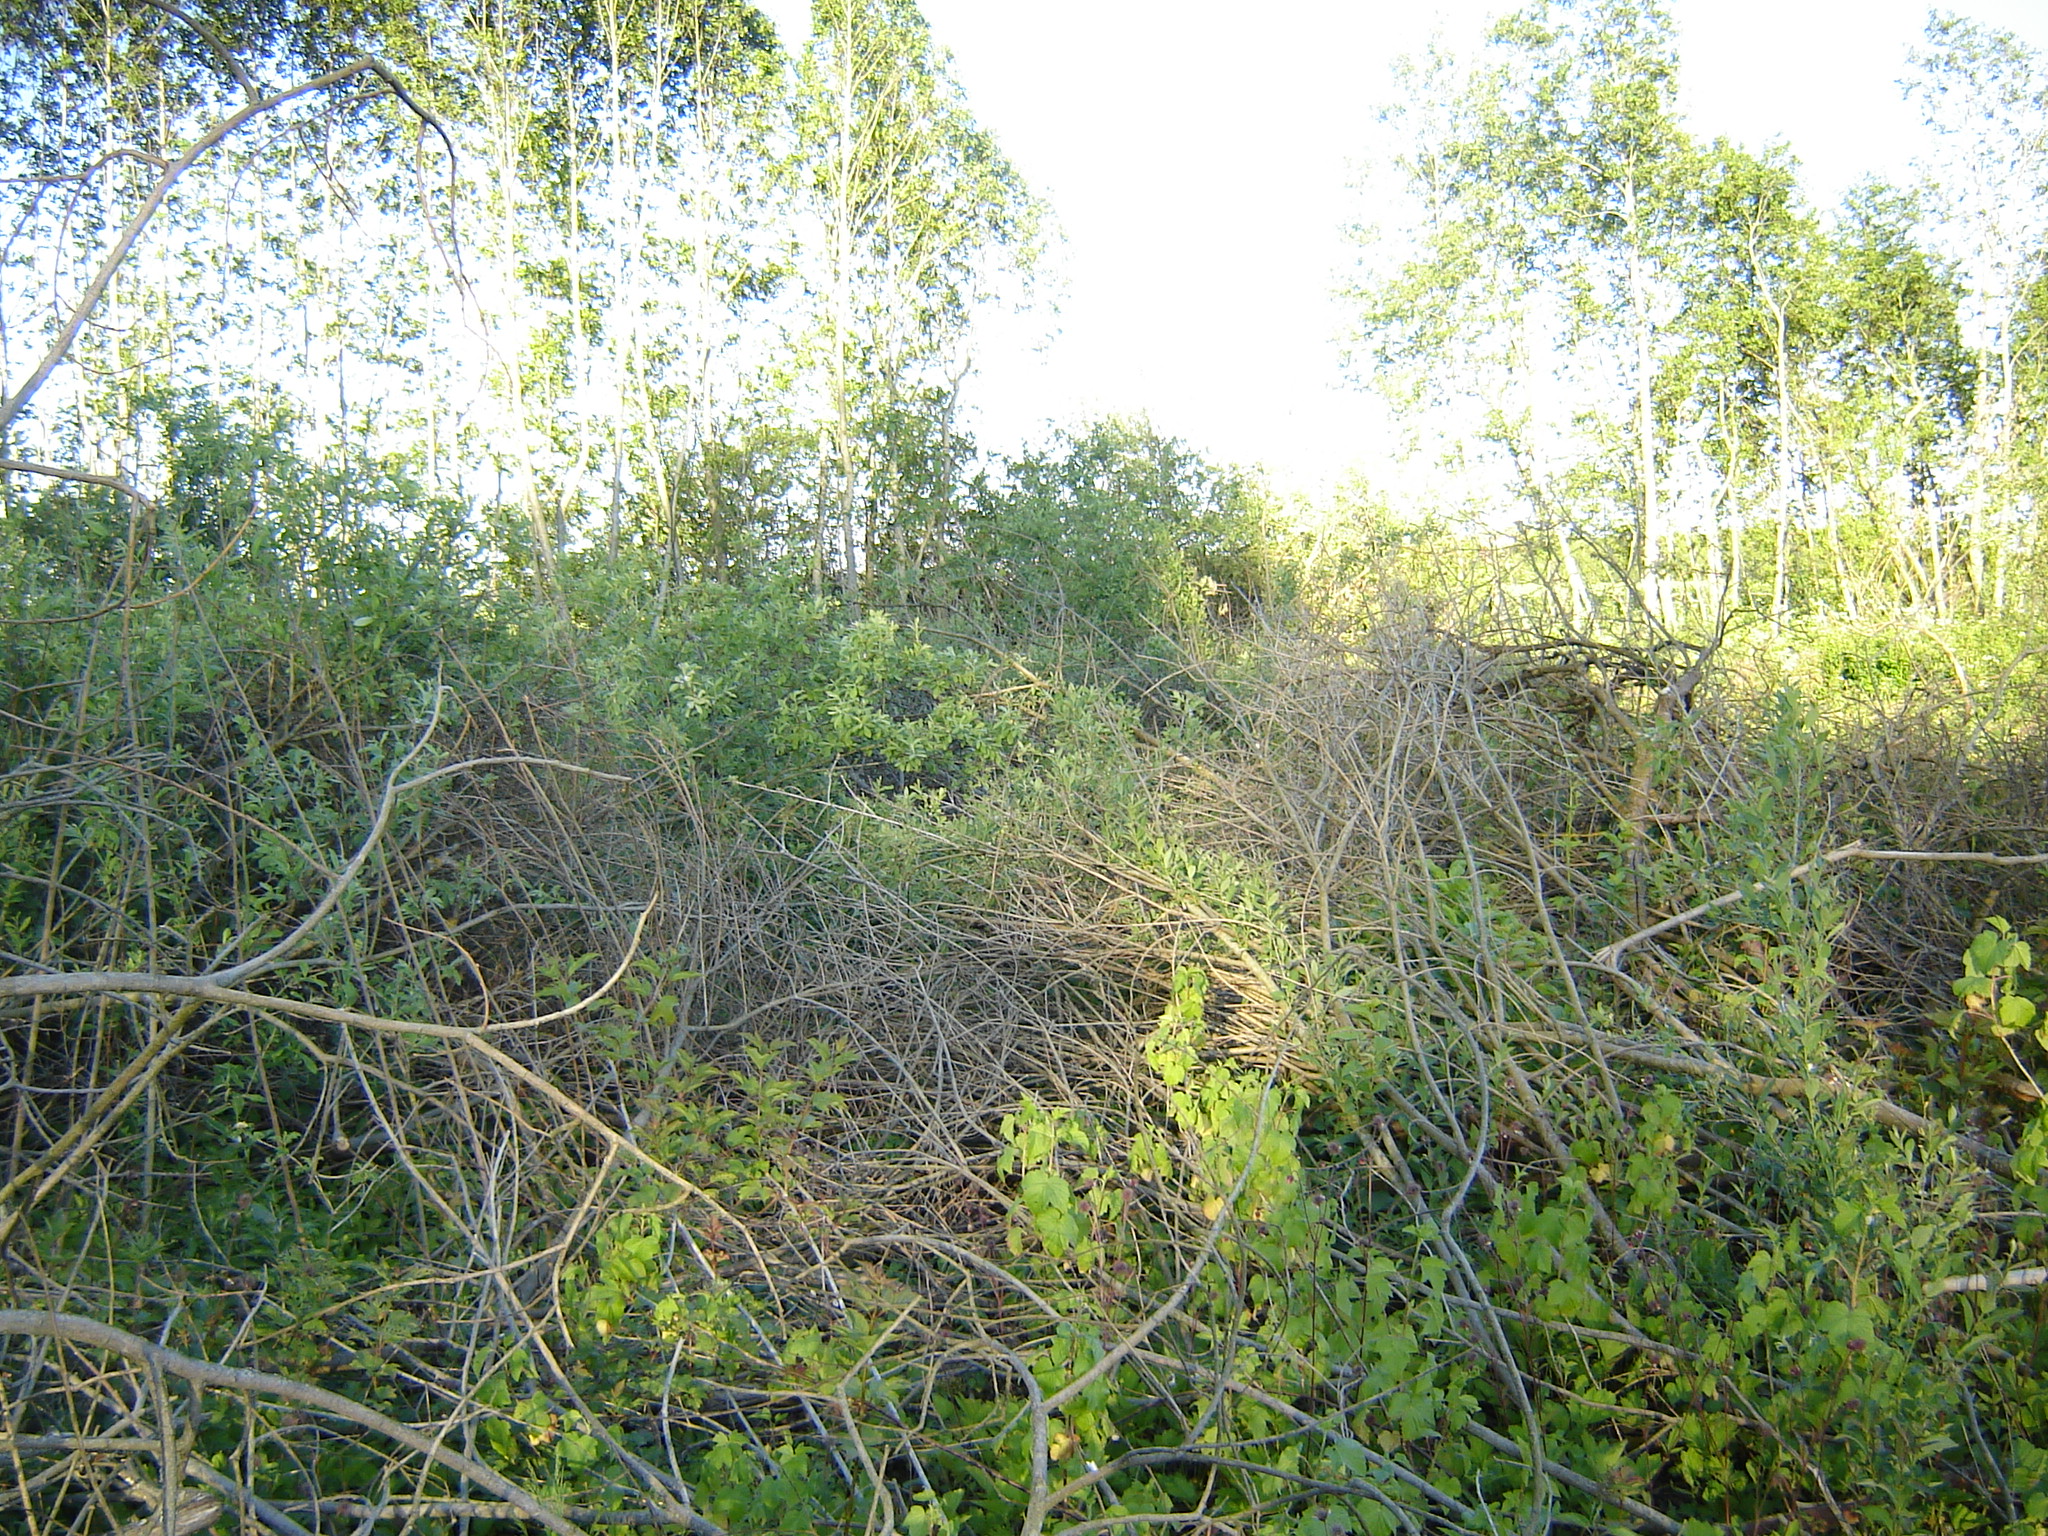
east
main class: Woodland
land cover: Broadleaved woodland
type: mire and swamp forests
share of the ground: > 75 %
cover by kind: broadleaved forest trees 75 %, shrubs 15 %, herbaceous plants 10 %
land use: Forestry
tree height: < 5 m
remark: Clear cut
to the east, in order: Broadleaved woodland; Ditches and canals; Broadleaved woodland; Shruby margins; Tracks; Rape and turnip rape
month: June
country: LT
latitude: 55.5500
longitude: 24.7356
